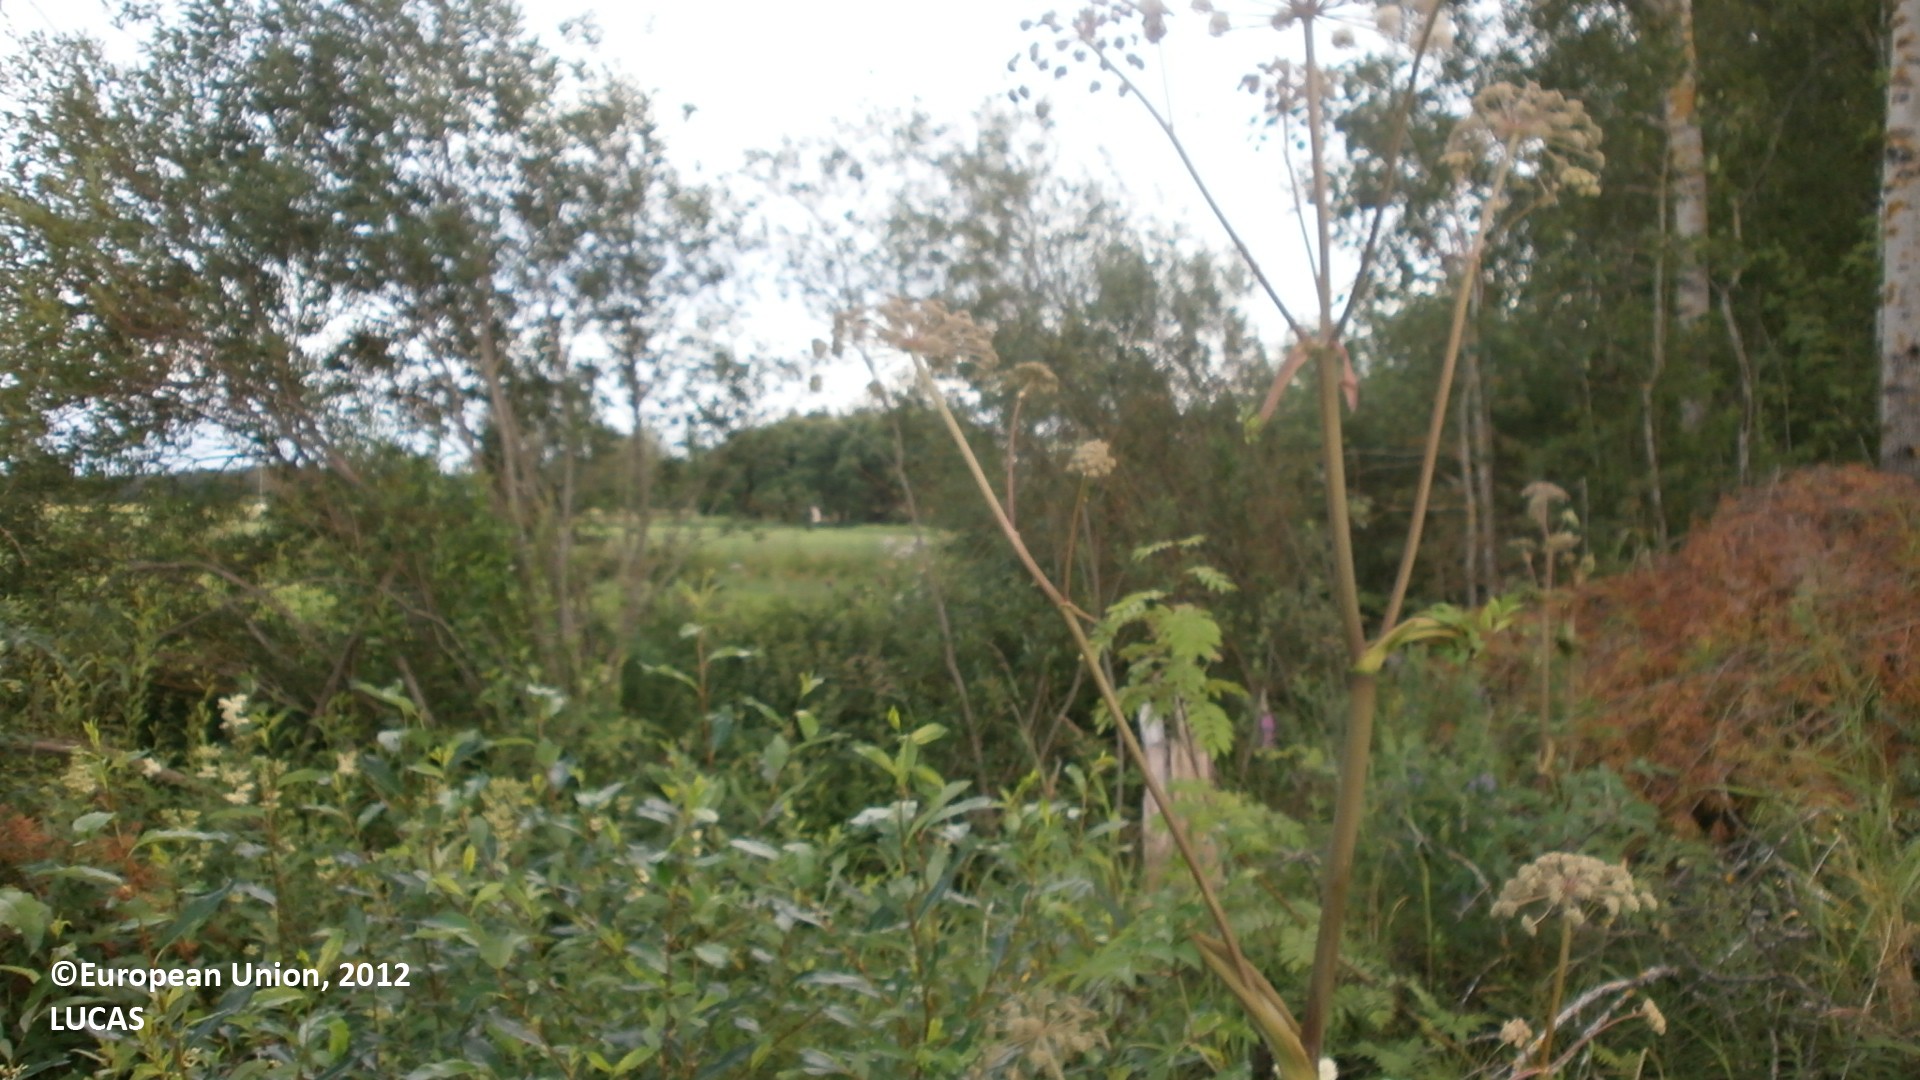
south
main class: Grassland
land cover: Grassland without tree/shrub cover
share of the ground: > 75 %
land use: Agriculture (excluding fallow land and kitchen gardens)
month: July
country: FI
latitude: 64.4535
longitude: 24.2178
